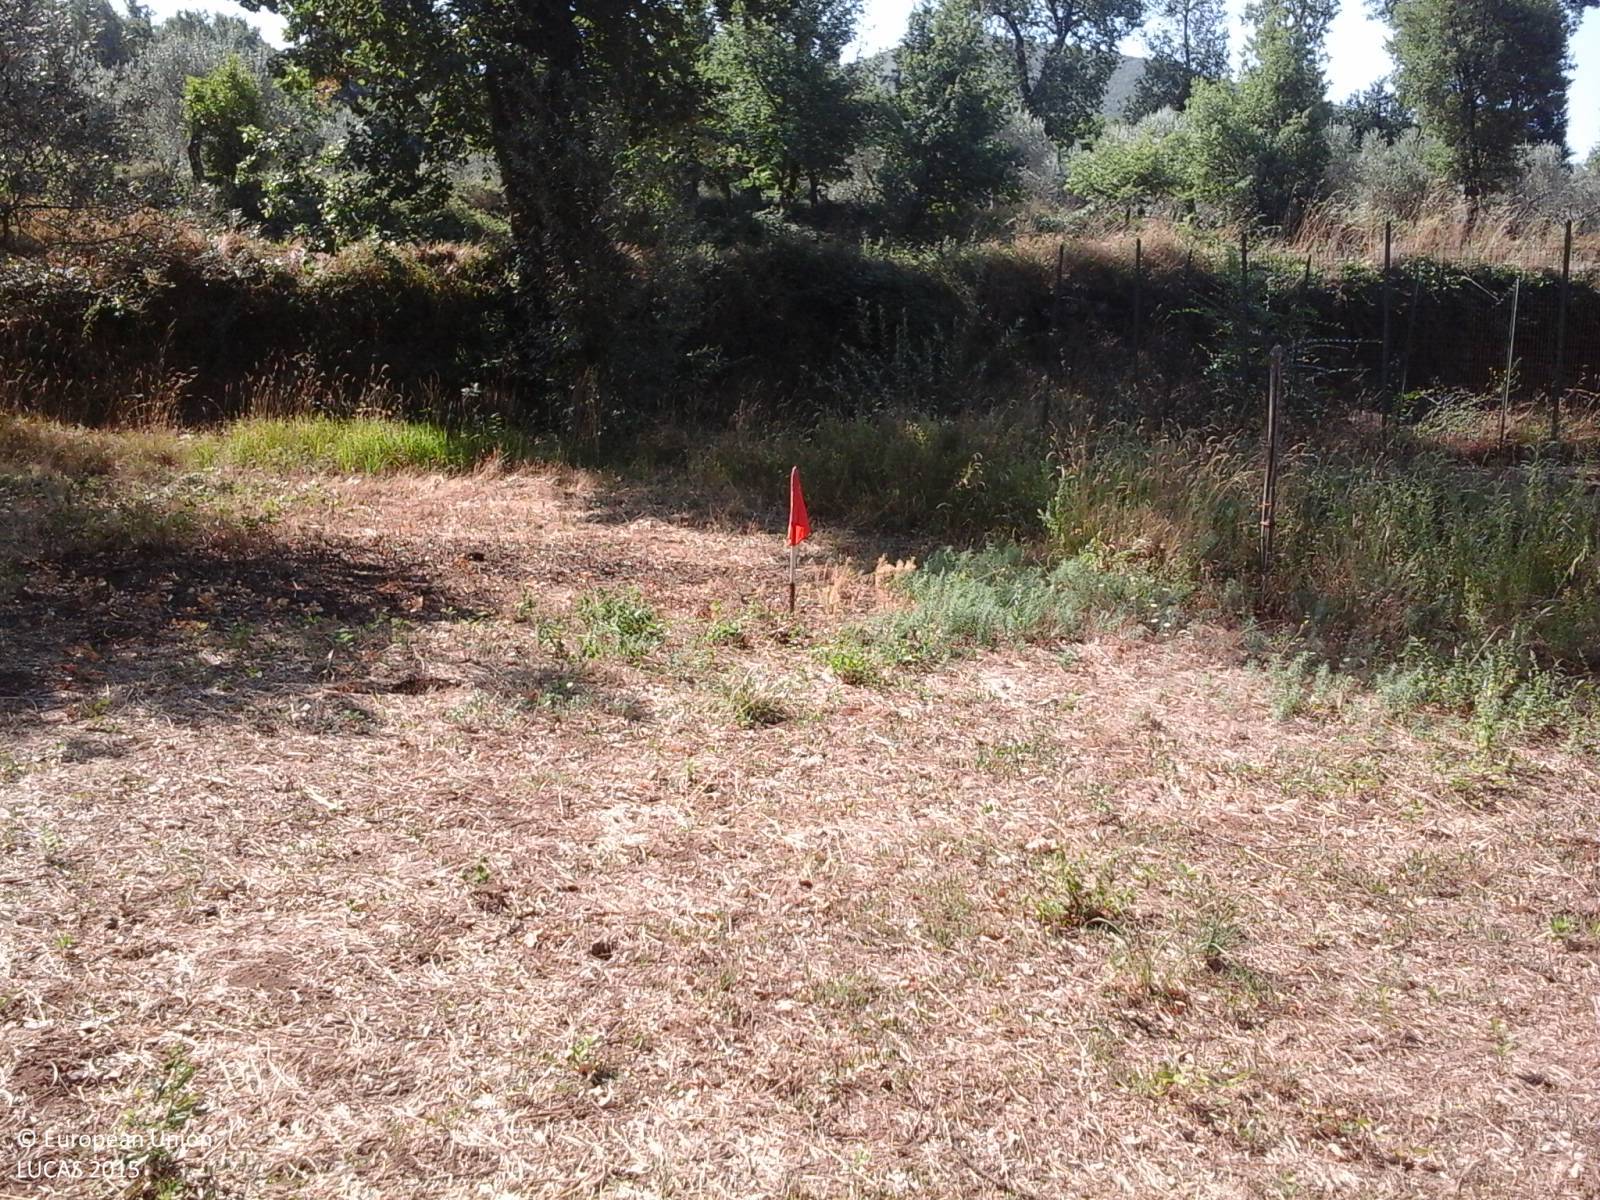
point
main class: Grassland
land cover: Spontaneously vegetated surfaces
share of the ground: > 75 %
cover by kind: herbaceous plants 100 %
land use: Fallow land
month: August
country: IT
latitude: 41.3292
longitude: 13.9396
